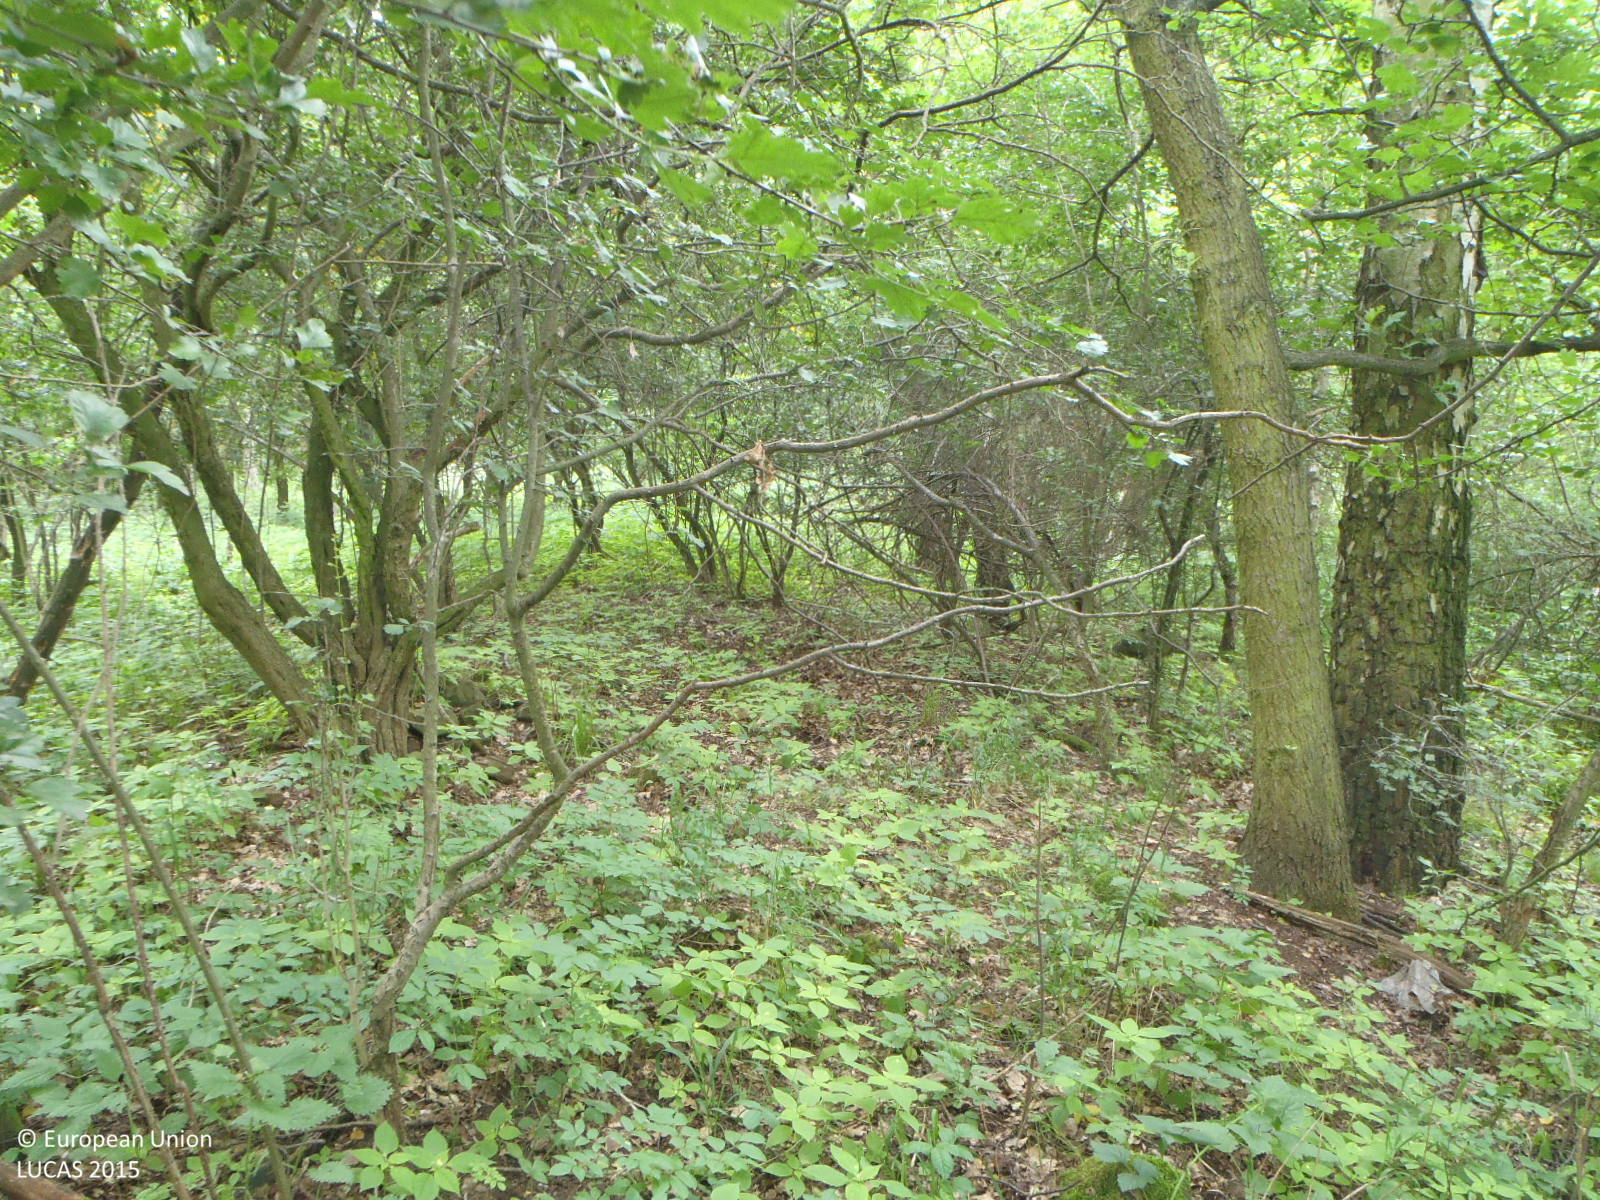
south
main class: Woodland
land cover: Broadleaved woodland
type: mesophytic deciduous forest
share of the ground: > 75 %
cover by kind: broadleaved forest trees 90 %, shrubs 5 %, herbaceous plants 5 %
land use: Forestry
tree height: > 5 m
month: June
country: CZ
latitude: 50.4983
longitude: 13.8213
